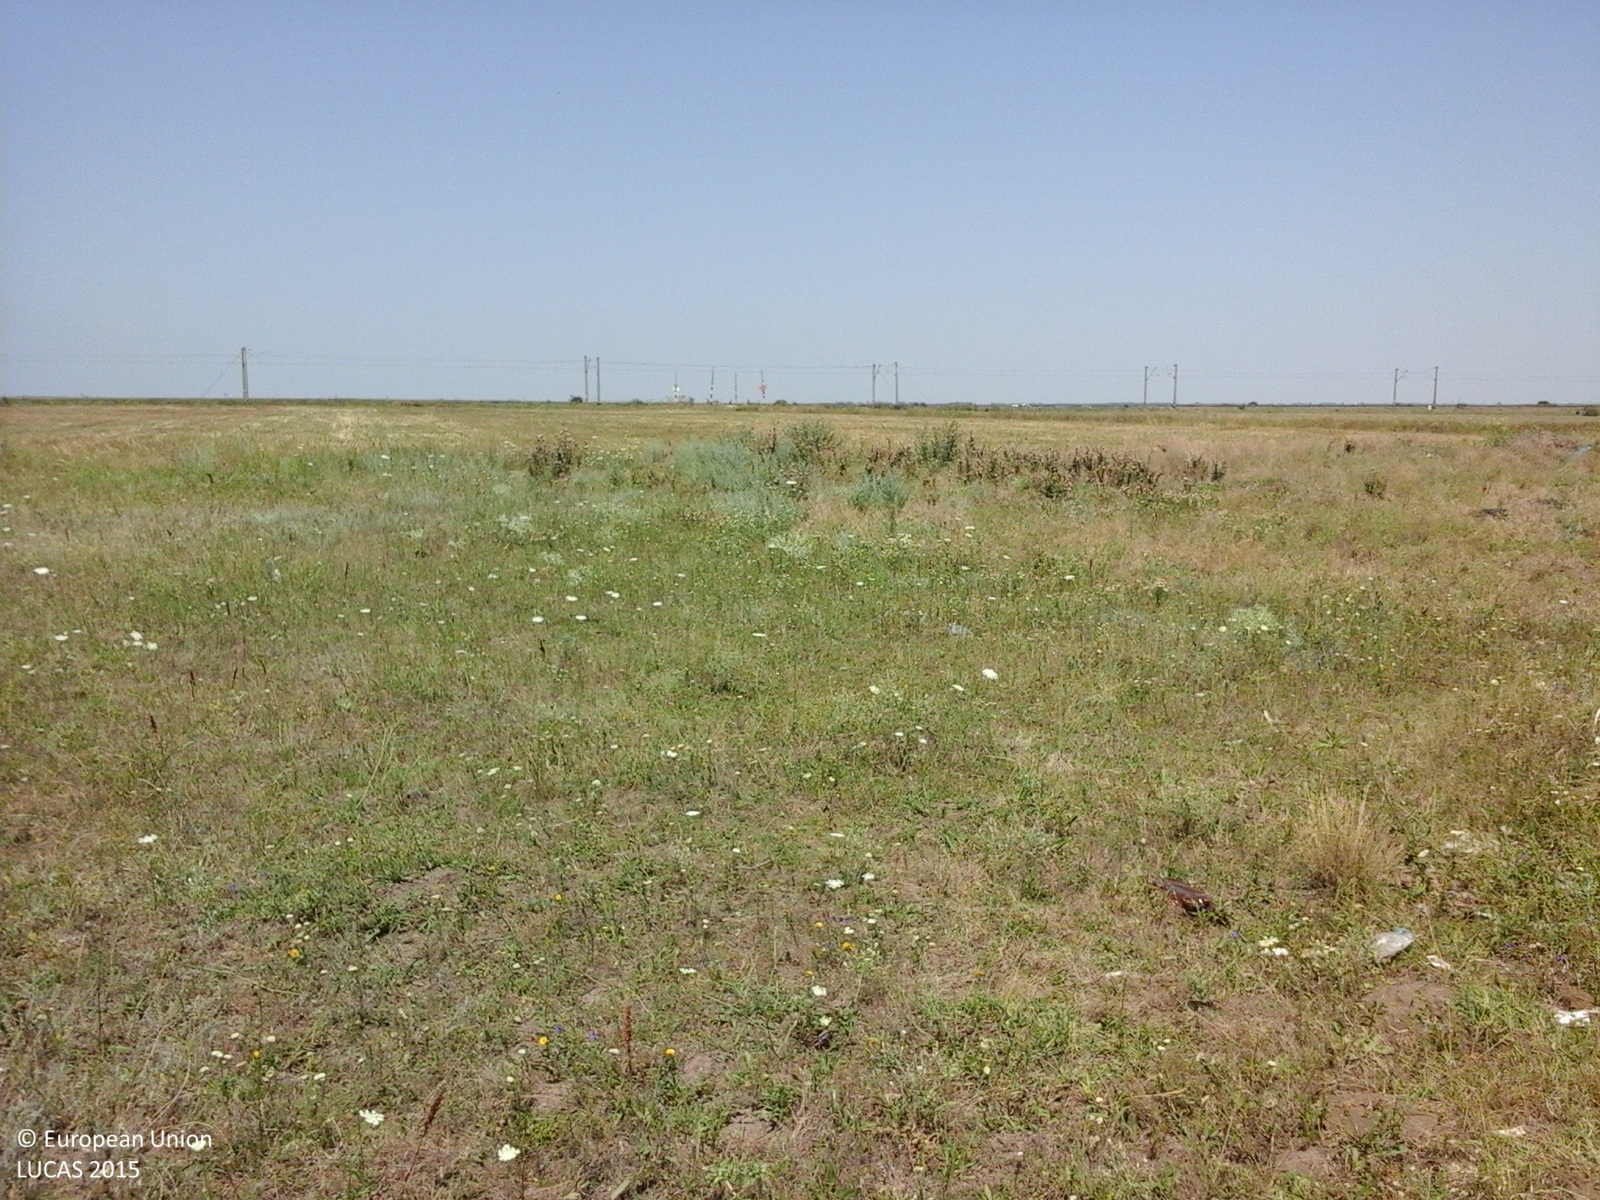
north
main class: Grassland
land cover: Spontaneously vegetated surfaces
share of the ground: > 75 %
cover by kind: herbaceous plants 100 %
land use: Agriculture (excluding fallow land and kitchen gardens)
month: July
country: RO
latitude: 45.0599
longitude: 27.1690
